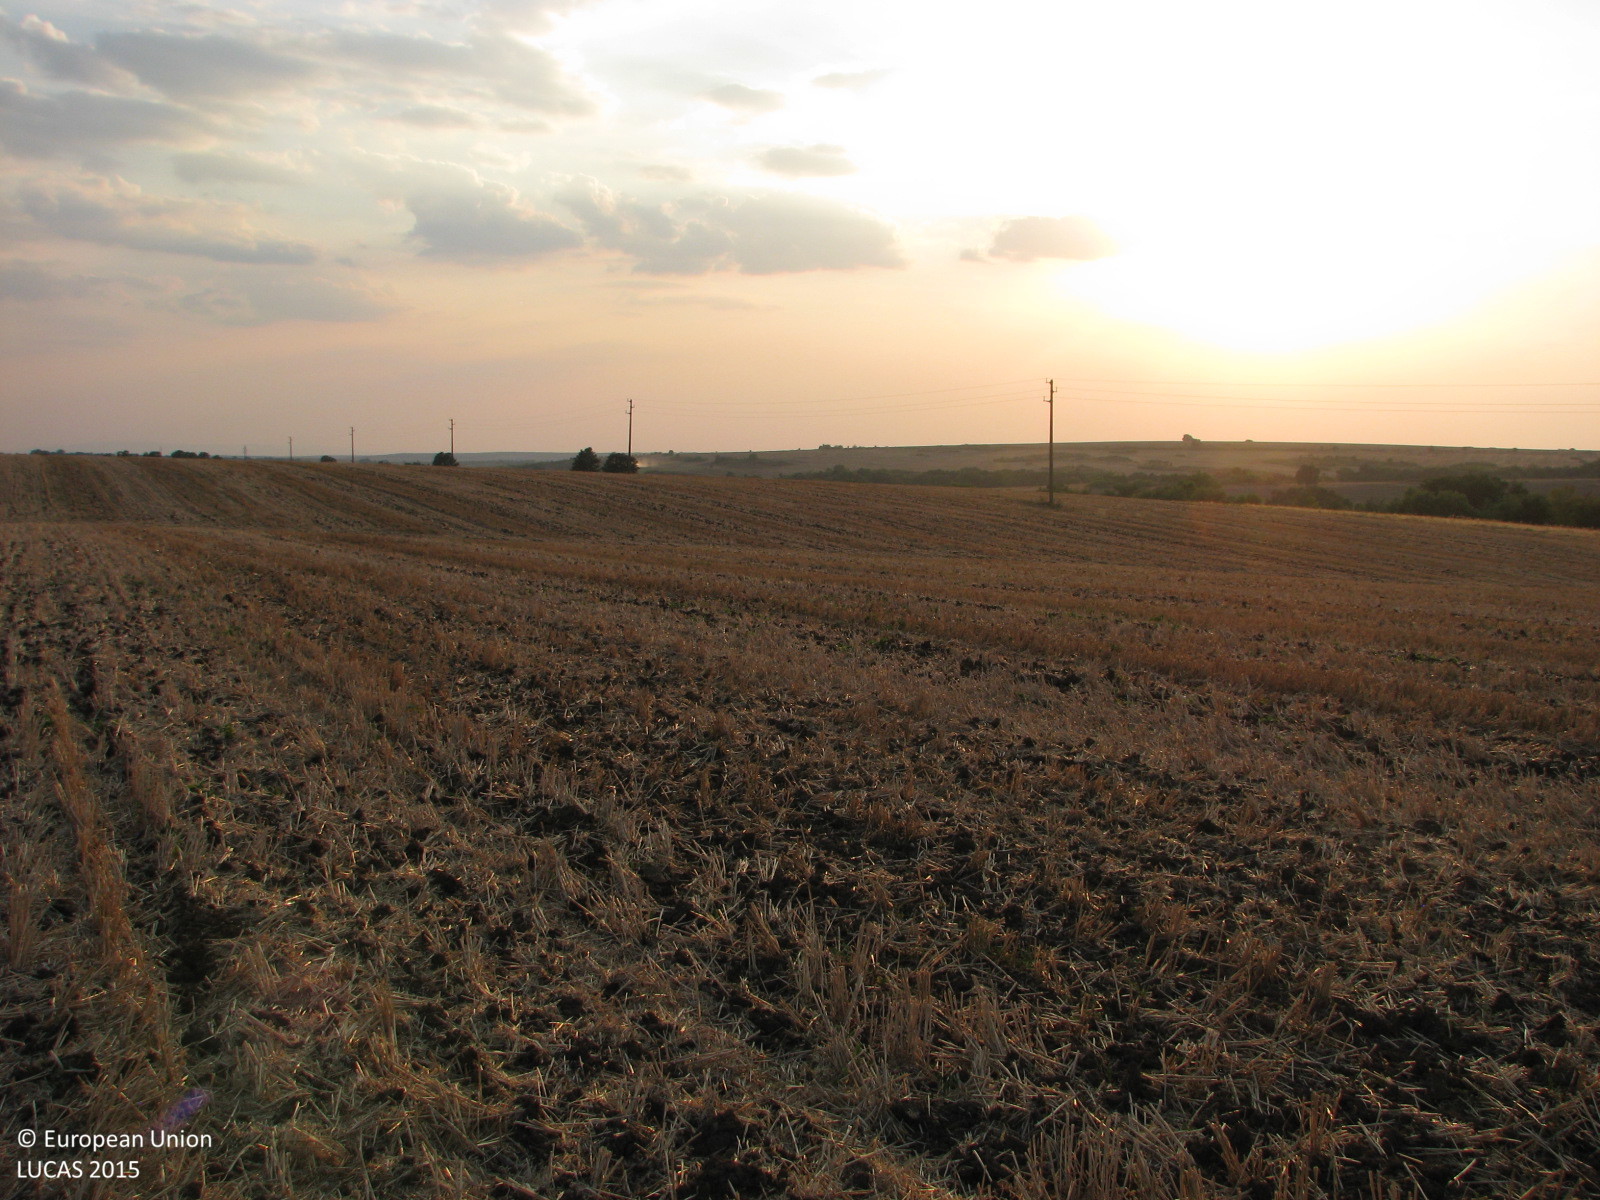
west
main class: Cropland
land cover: Common wheat
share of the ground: 25 - 50 %
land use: Agriculture (excluding fallow land and kitchen gardens)
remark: Harvested field
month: August
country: BG
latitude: 42.1808
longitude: 26.8901
